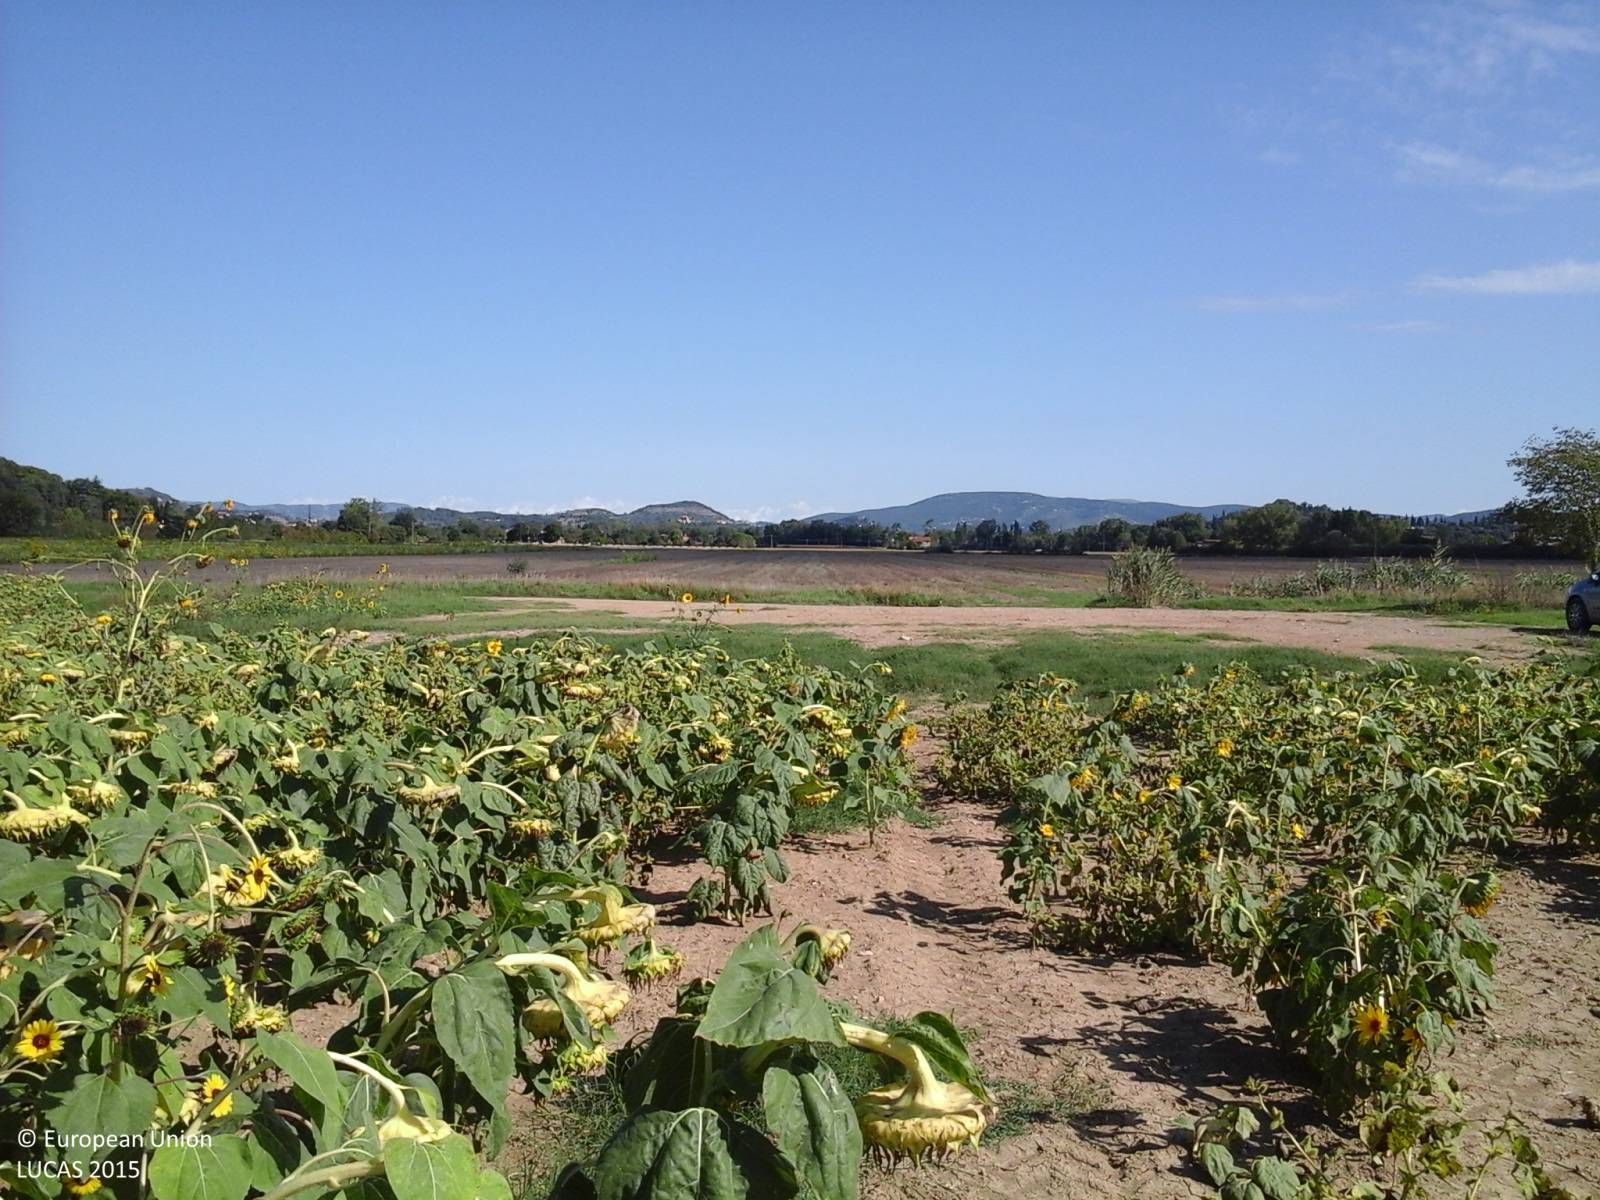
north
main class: Cropland
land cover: Sunflower
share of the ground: > 75 %
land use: Agriculture (excluding fallow land and kitchen gardens)
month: September
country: IT
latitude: 43.0262
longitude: 12.2636
